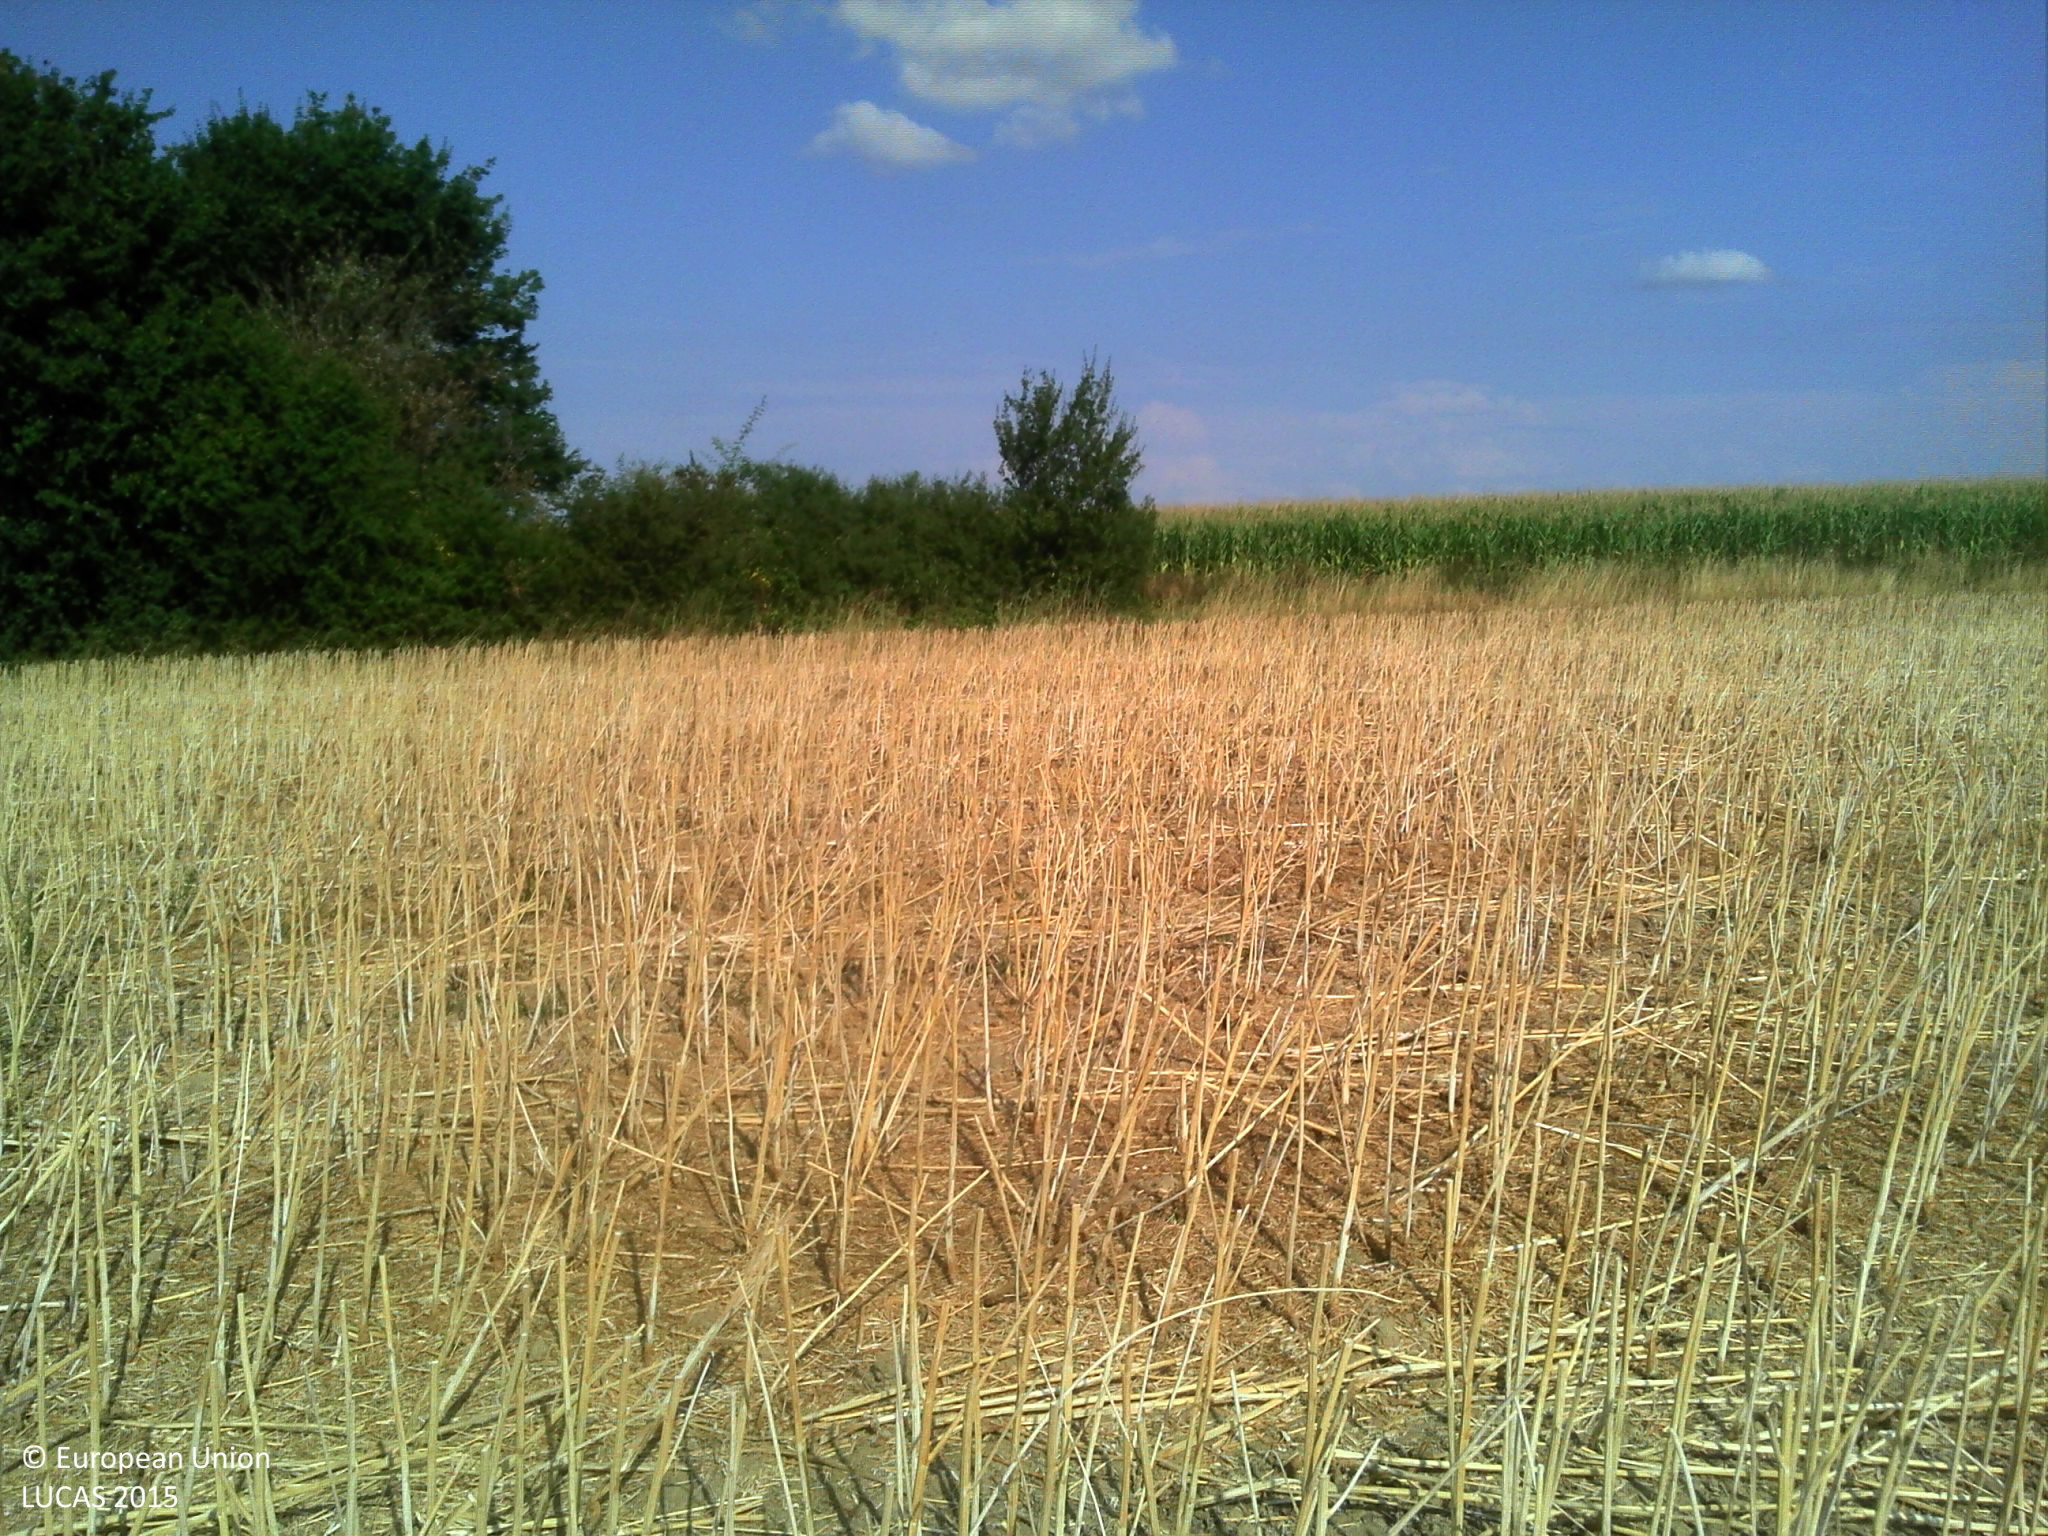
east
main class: Cropland
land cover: Rape and turnip rape
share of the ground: > 75 %
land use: Agriculture (excluding fallow land and kitchen gardens)
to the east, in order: Rape and turnip rape; Tracks; Broadleaved woodland; Maize; Temporary grasslands
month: July
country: FR
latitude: 46.8994
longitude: 4.9475
